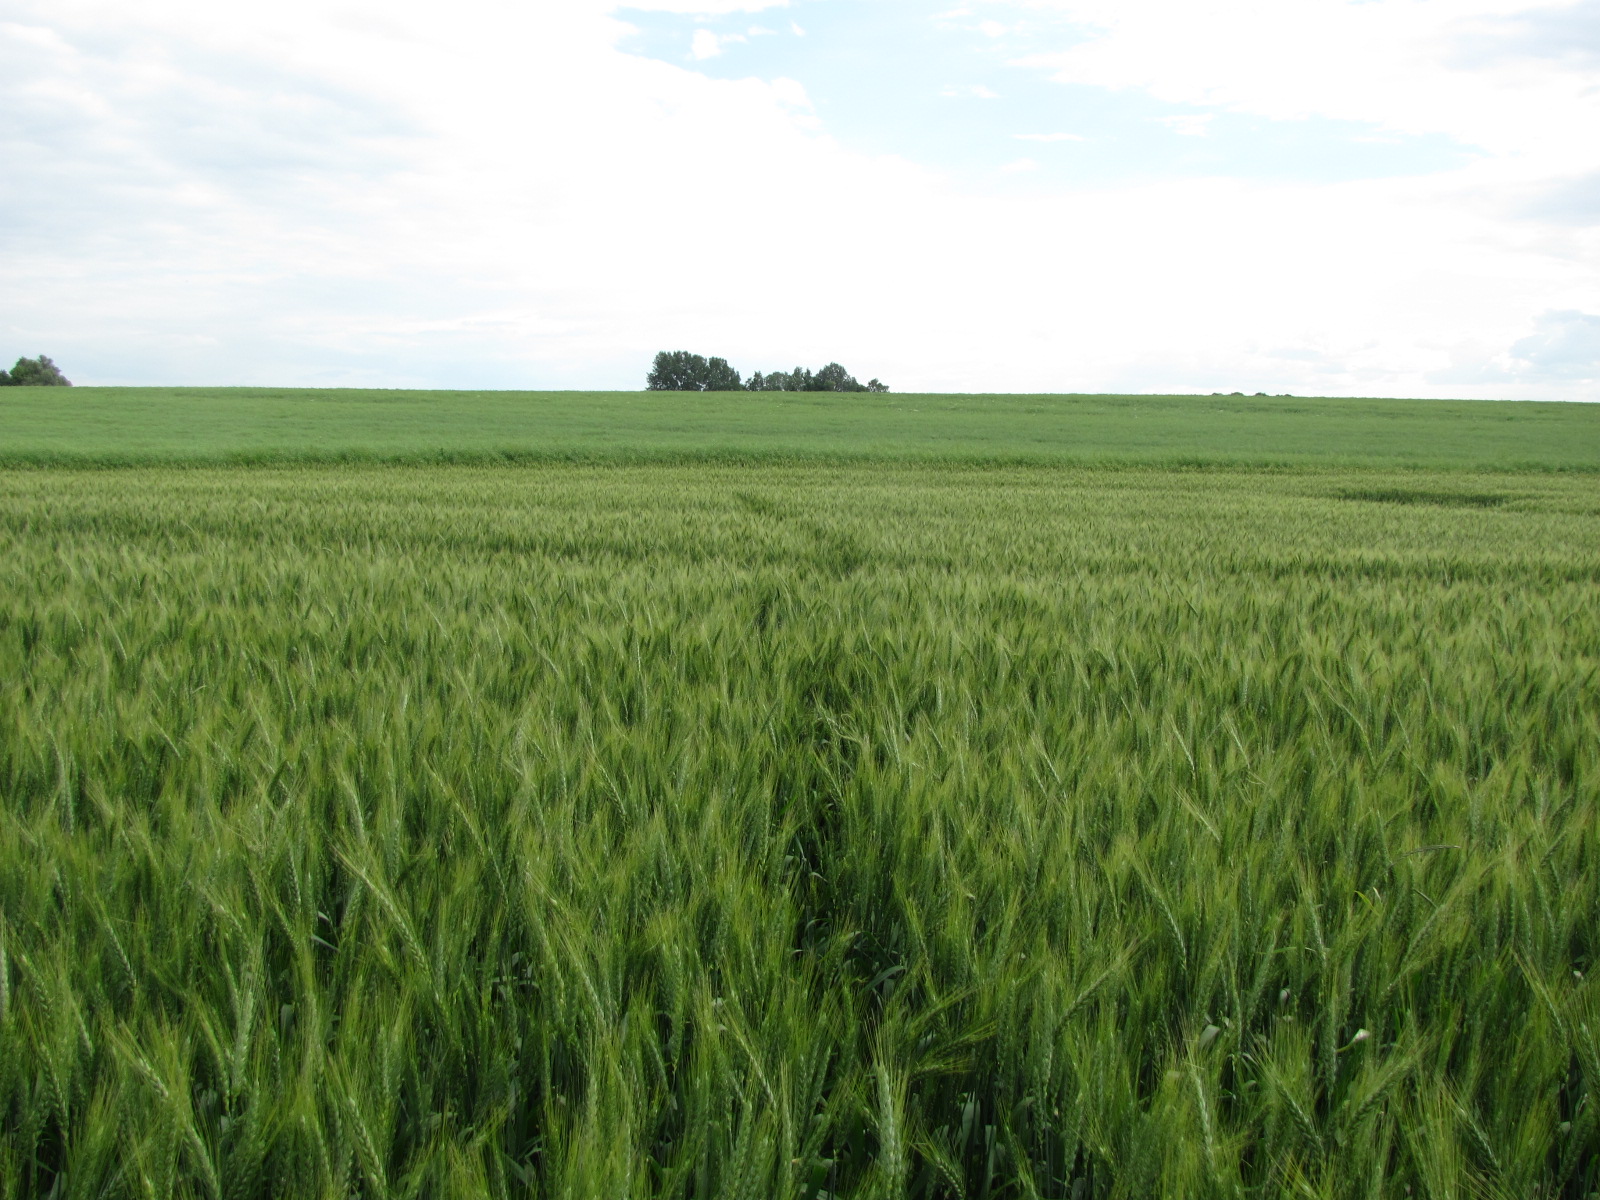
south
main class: Cropland
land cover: Triticale
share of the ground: > 75 %
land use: Agriculture (excluding fallow land and kitchen gardens)
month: June
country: LV
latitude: 56.5108
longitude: 24.0115
